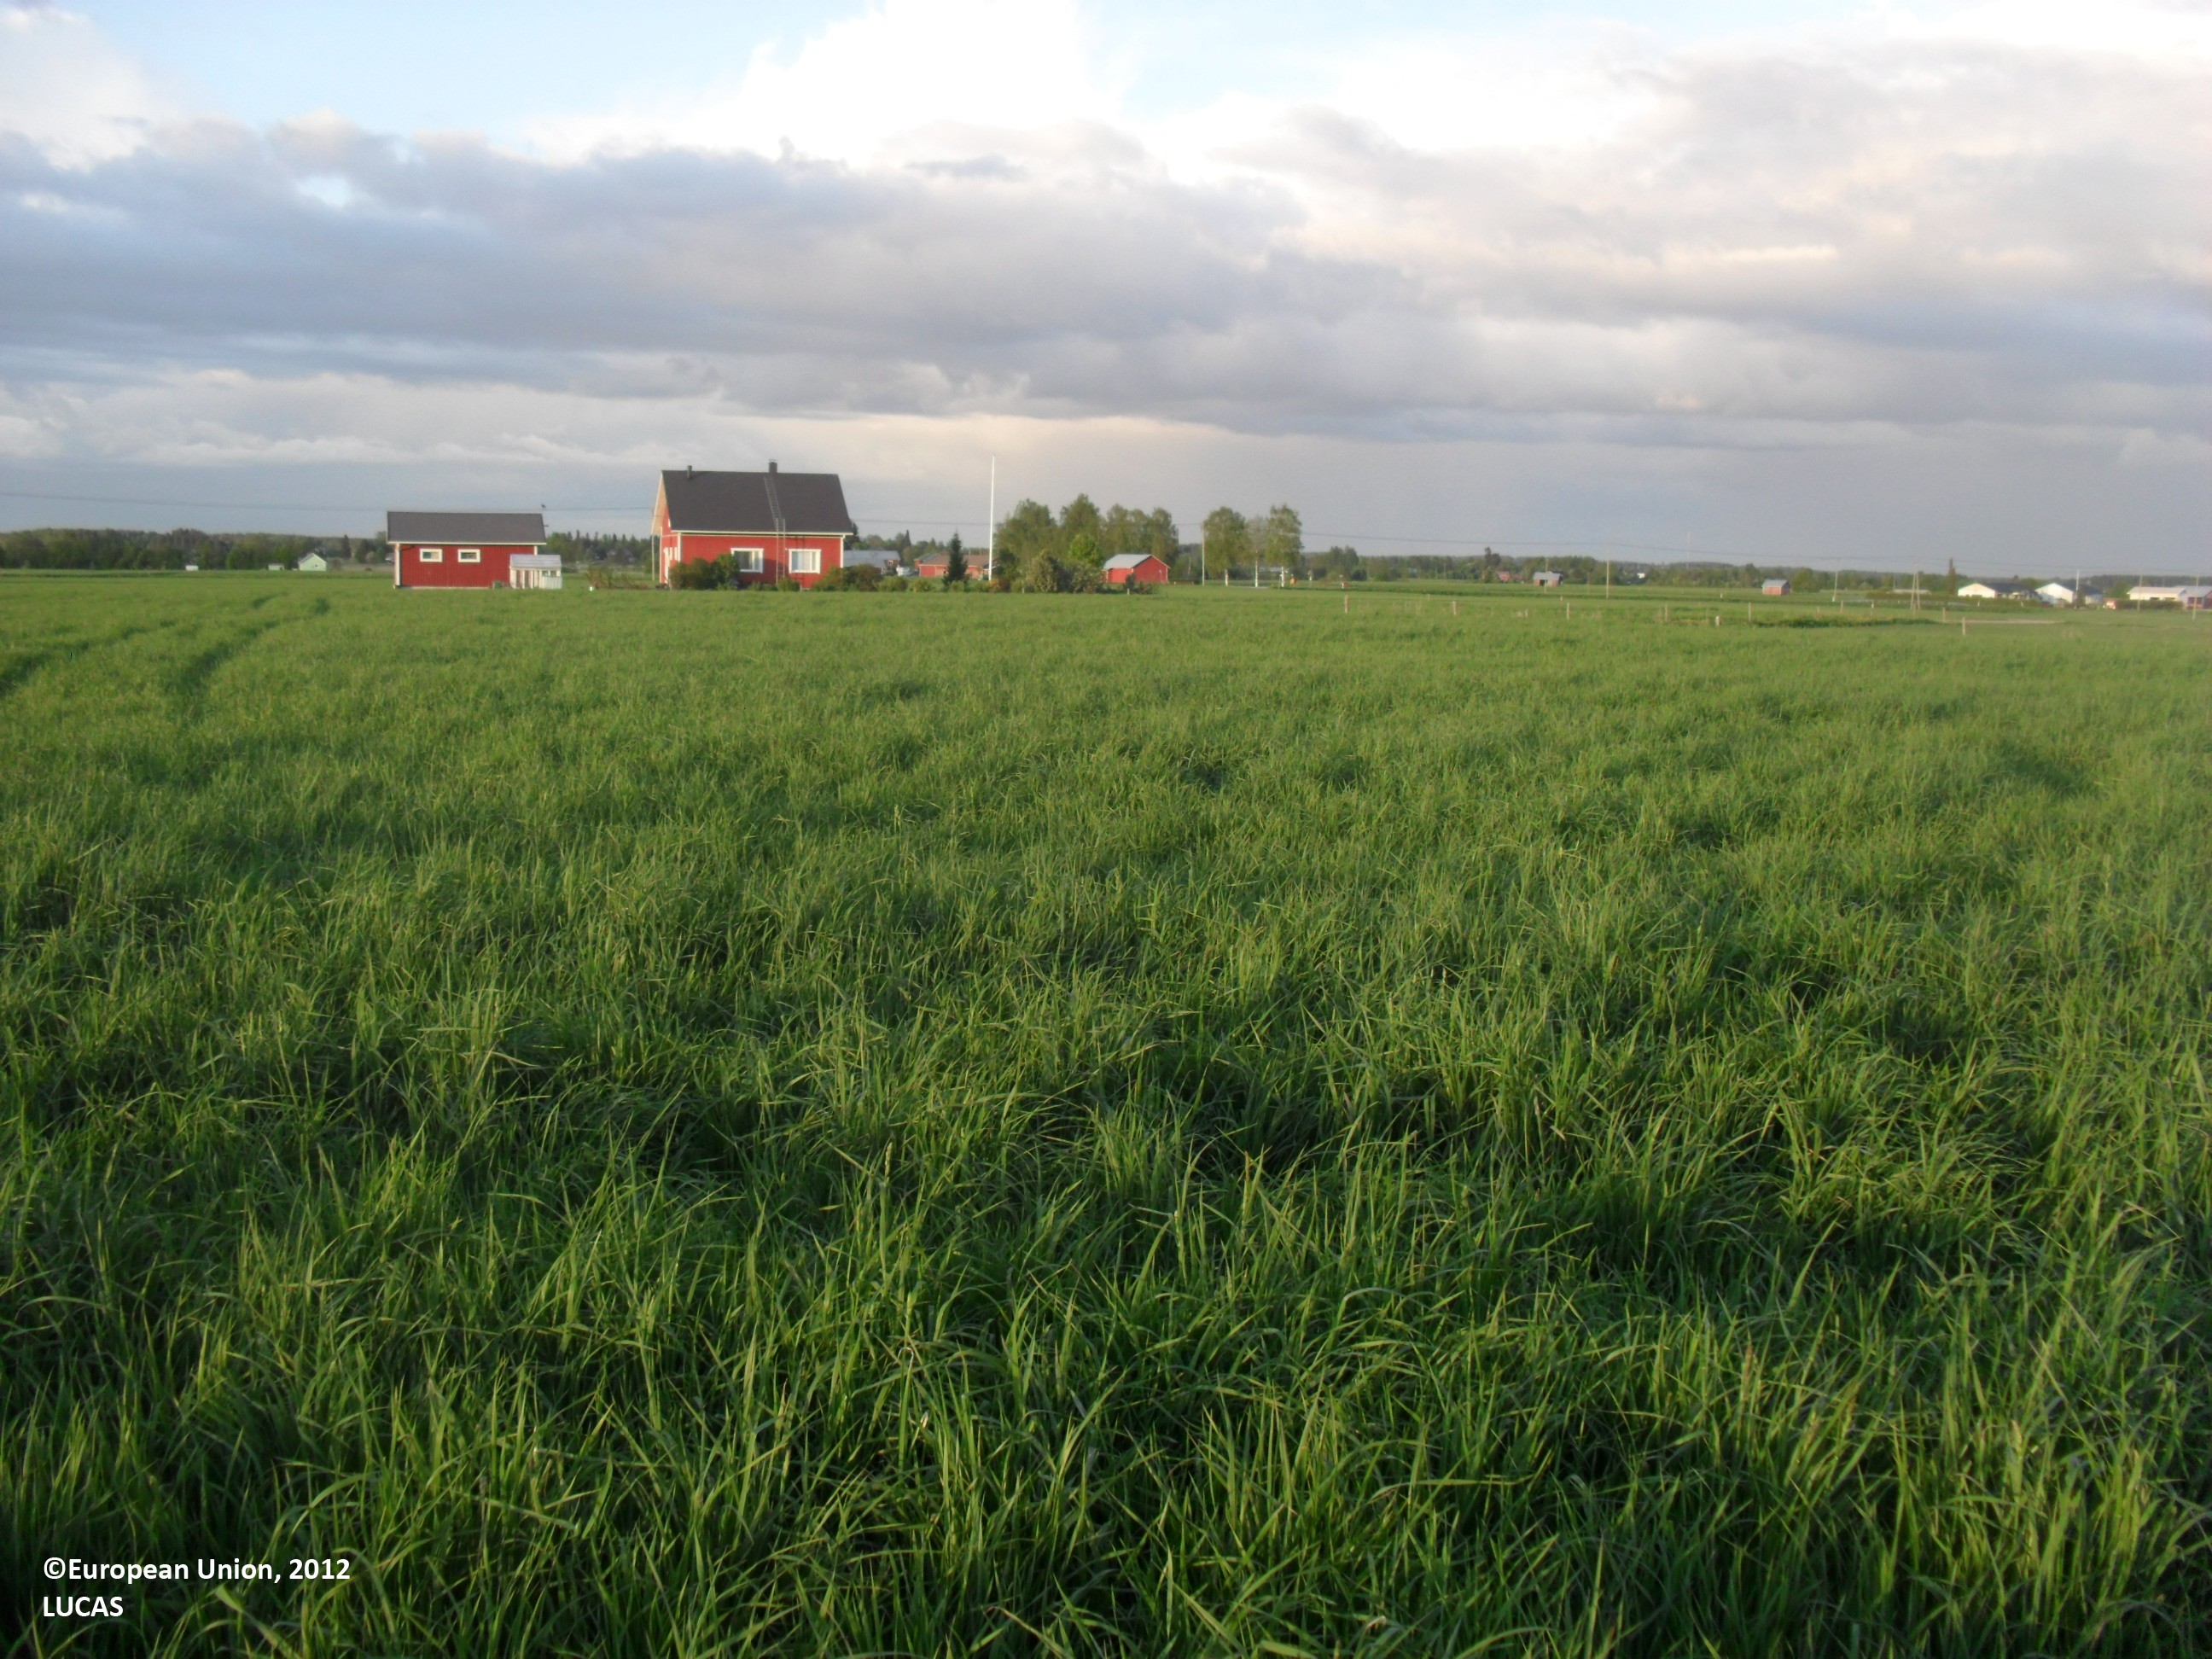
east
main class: Cropland
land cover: Temporary grasslands
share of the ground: > 75 %
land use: Agriculture (excluding fallow land and kitchen gardens)
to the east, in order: Temporary grasslands; Fences; Grassland with sparse tree/shrub cover; Electric lines; Oats; Paved roads, cycling and walking lanes; Ditches and canals; Temporary grasslands
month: June
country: FI
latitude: 62.9088
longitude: 23.1906
